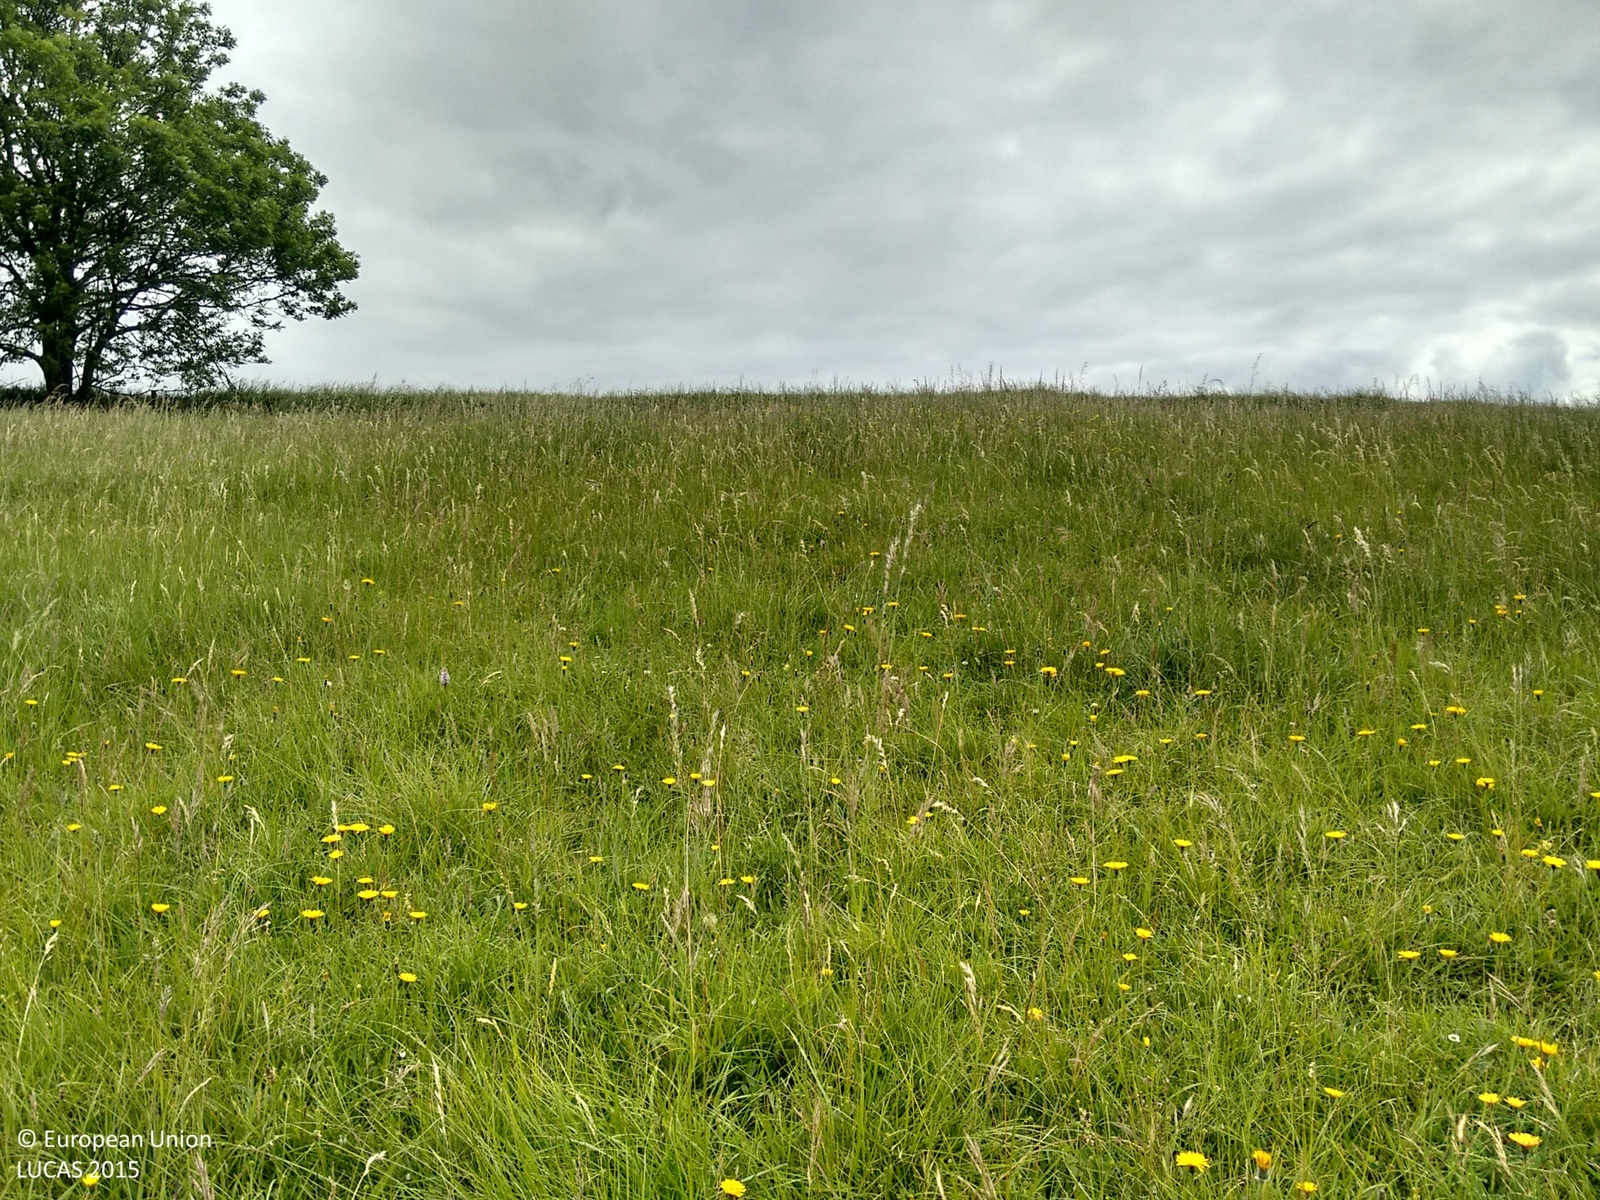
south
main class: Grassland
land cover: Grassland without tree/shrub cover
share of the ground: > 75 %
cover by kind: herbaceous plants 100 %
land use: Agriculture (excluding fallow land and kitchen gardens)
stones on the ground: < 10 %
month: June
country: GB
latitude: 50.8780
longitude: -0.0818
